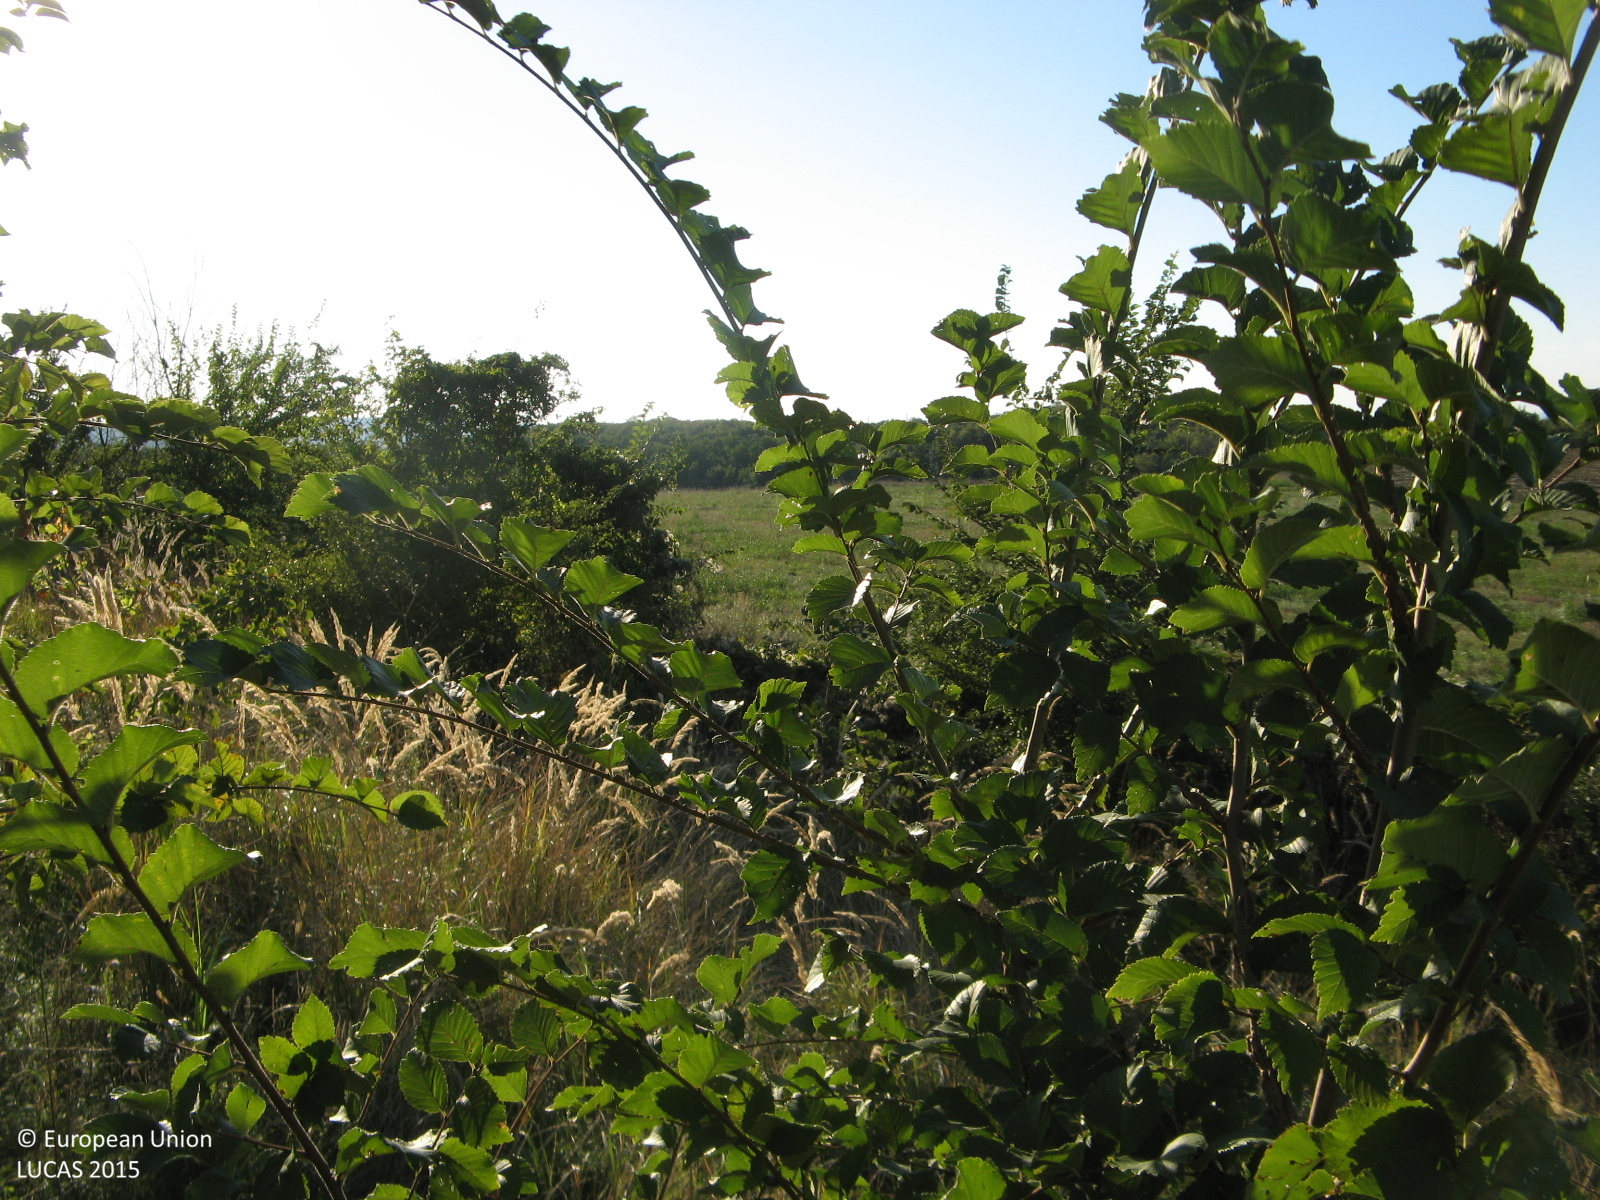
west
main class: Grassland
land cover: Grassland with sparse tree/shrub cover
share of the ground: > 75 %
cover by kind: herbaceous plants 90 %, broadleaved forest trees 5 %, shrubs 5 %
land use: Semi-natural and natural areas not in use
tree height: < 5 m
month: September
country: BG
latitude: 43.6096
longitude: 25.4324
